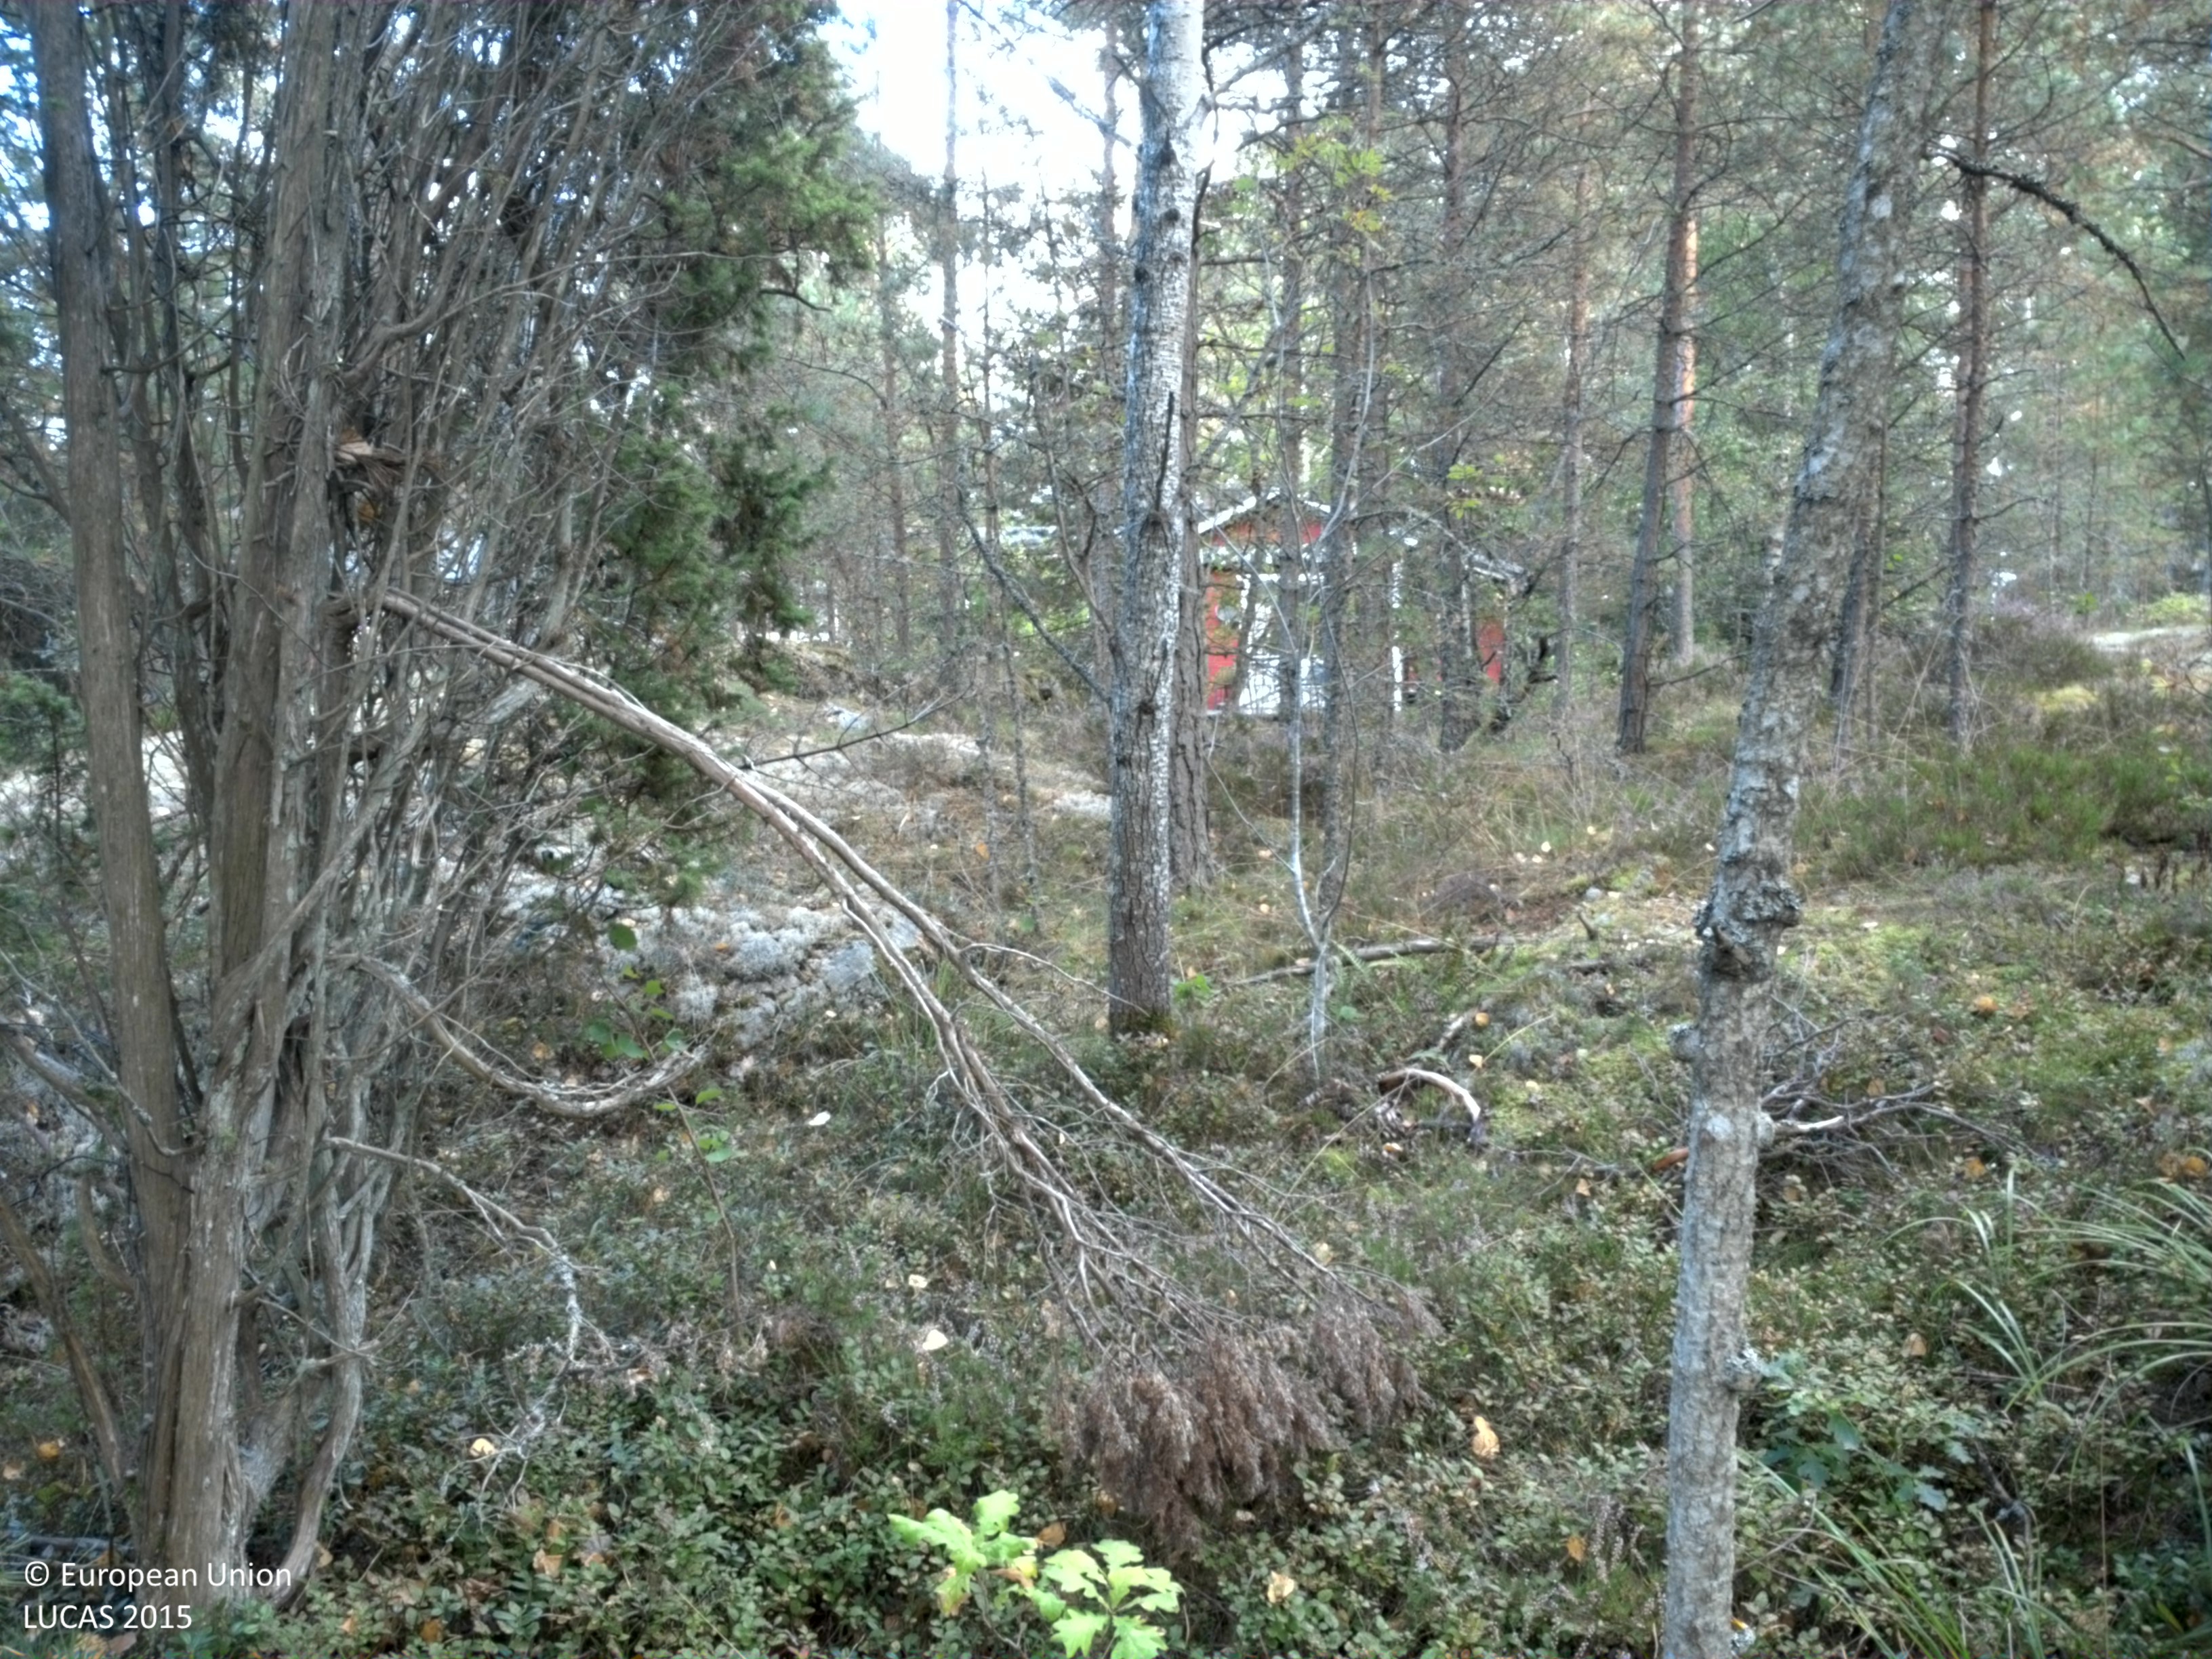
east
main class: Woodland
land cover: Pine dominated coniferous woodland
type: boreal forest
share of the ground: 50 - 75 %
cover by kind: coniferous forest trees 55 %, lichens and mosses 20 %, shrubs 15 %, broadleaved forest trees 10 %
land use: Amenities, museums, leisure
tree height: > 5 m
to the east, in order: Pine dominated coniferous woodland; Artificial constructions in urban areas; Pine dominated coniferous woodland; Artificial constructions in urban areas; Pine dominated mixed woodland; Paved roads, cycling and walking lanes; Fences; Pine dominated coniferous woodland; Artificial constructions in urban areas; Pine dominated coniferous woodland; Tracks; Pine dominated coniferous woodland
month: September
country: SE
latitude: 59.3538
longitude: 18.6375
